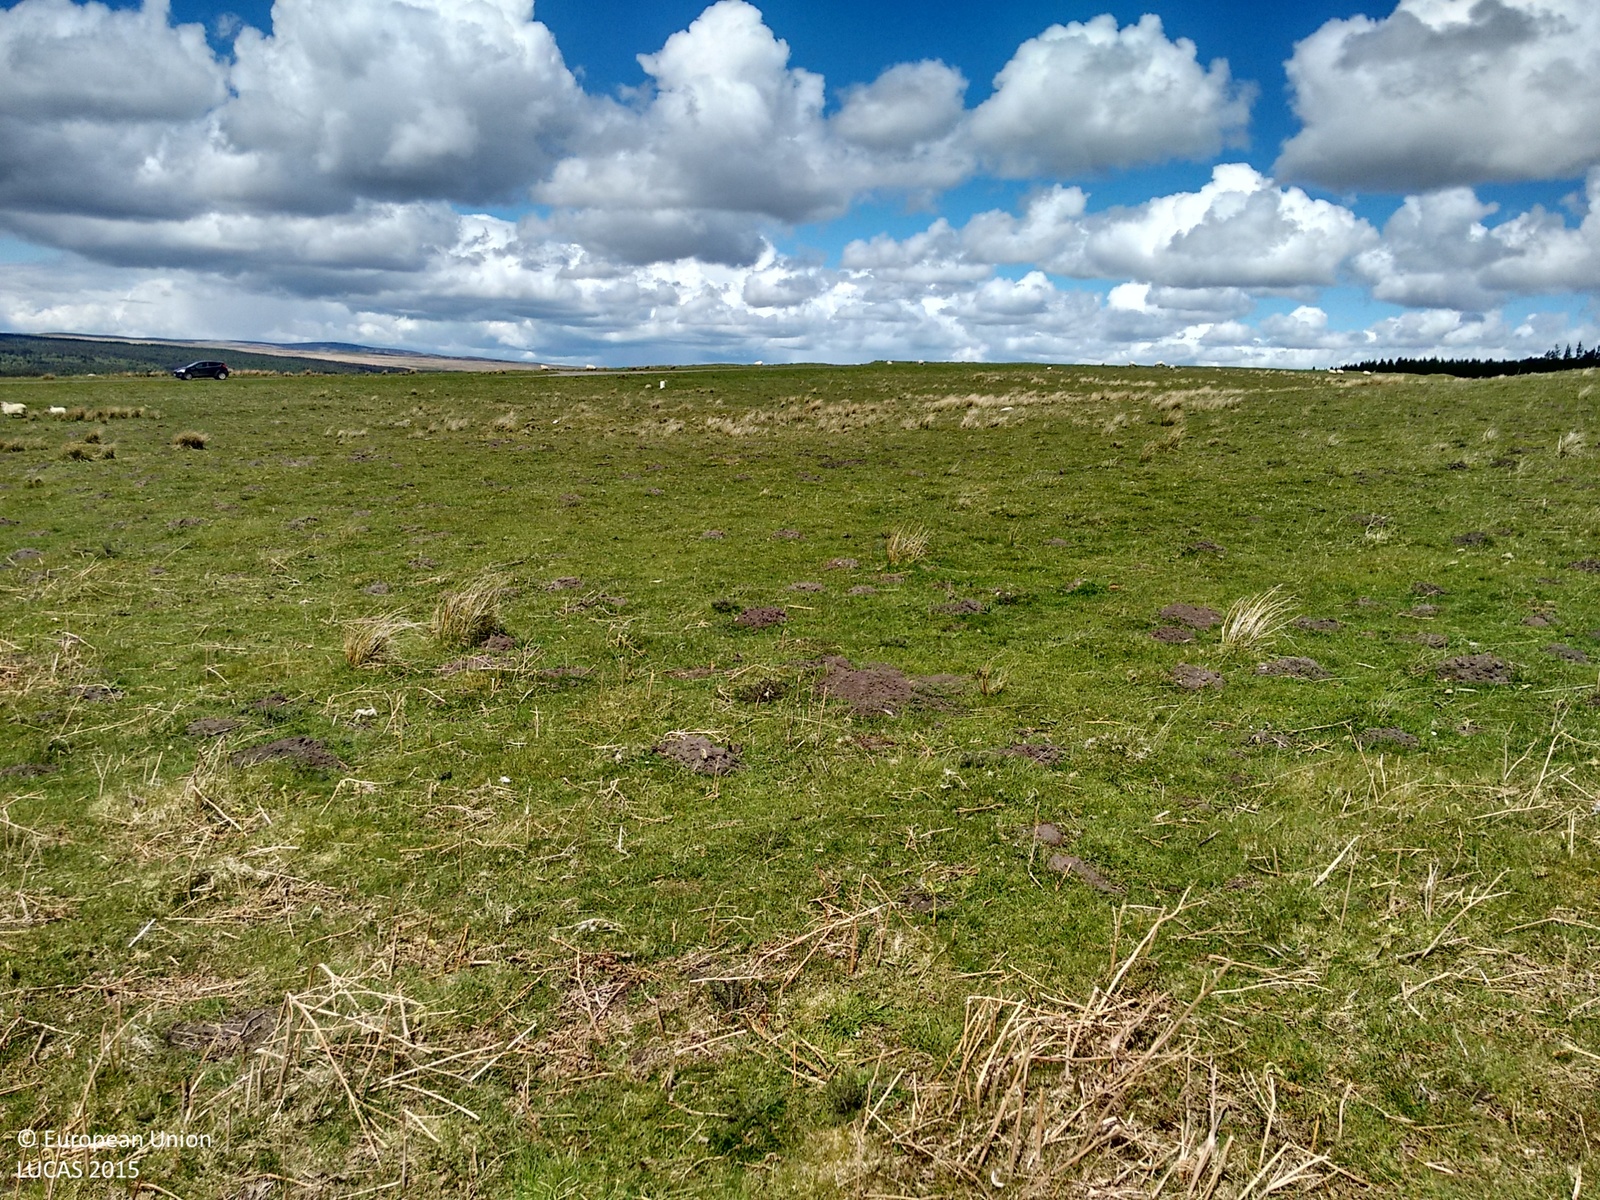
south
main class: Grassland
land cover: Grassland without tree/shrub cover
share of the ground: > 75 %
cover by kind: herbaceous plants 100 %
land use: Agriculture (excluding fallow land and kitchen gardens)
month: May
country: GB
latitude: 55.2759
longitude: -2.1933
